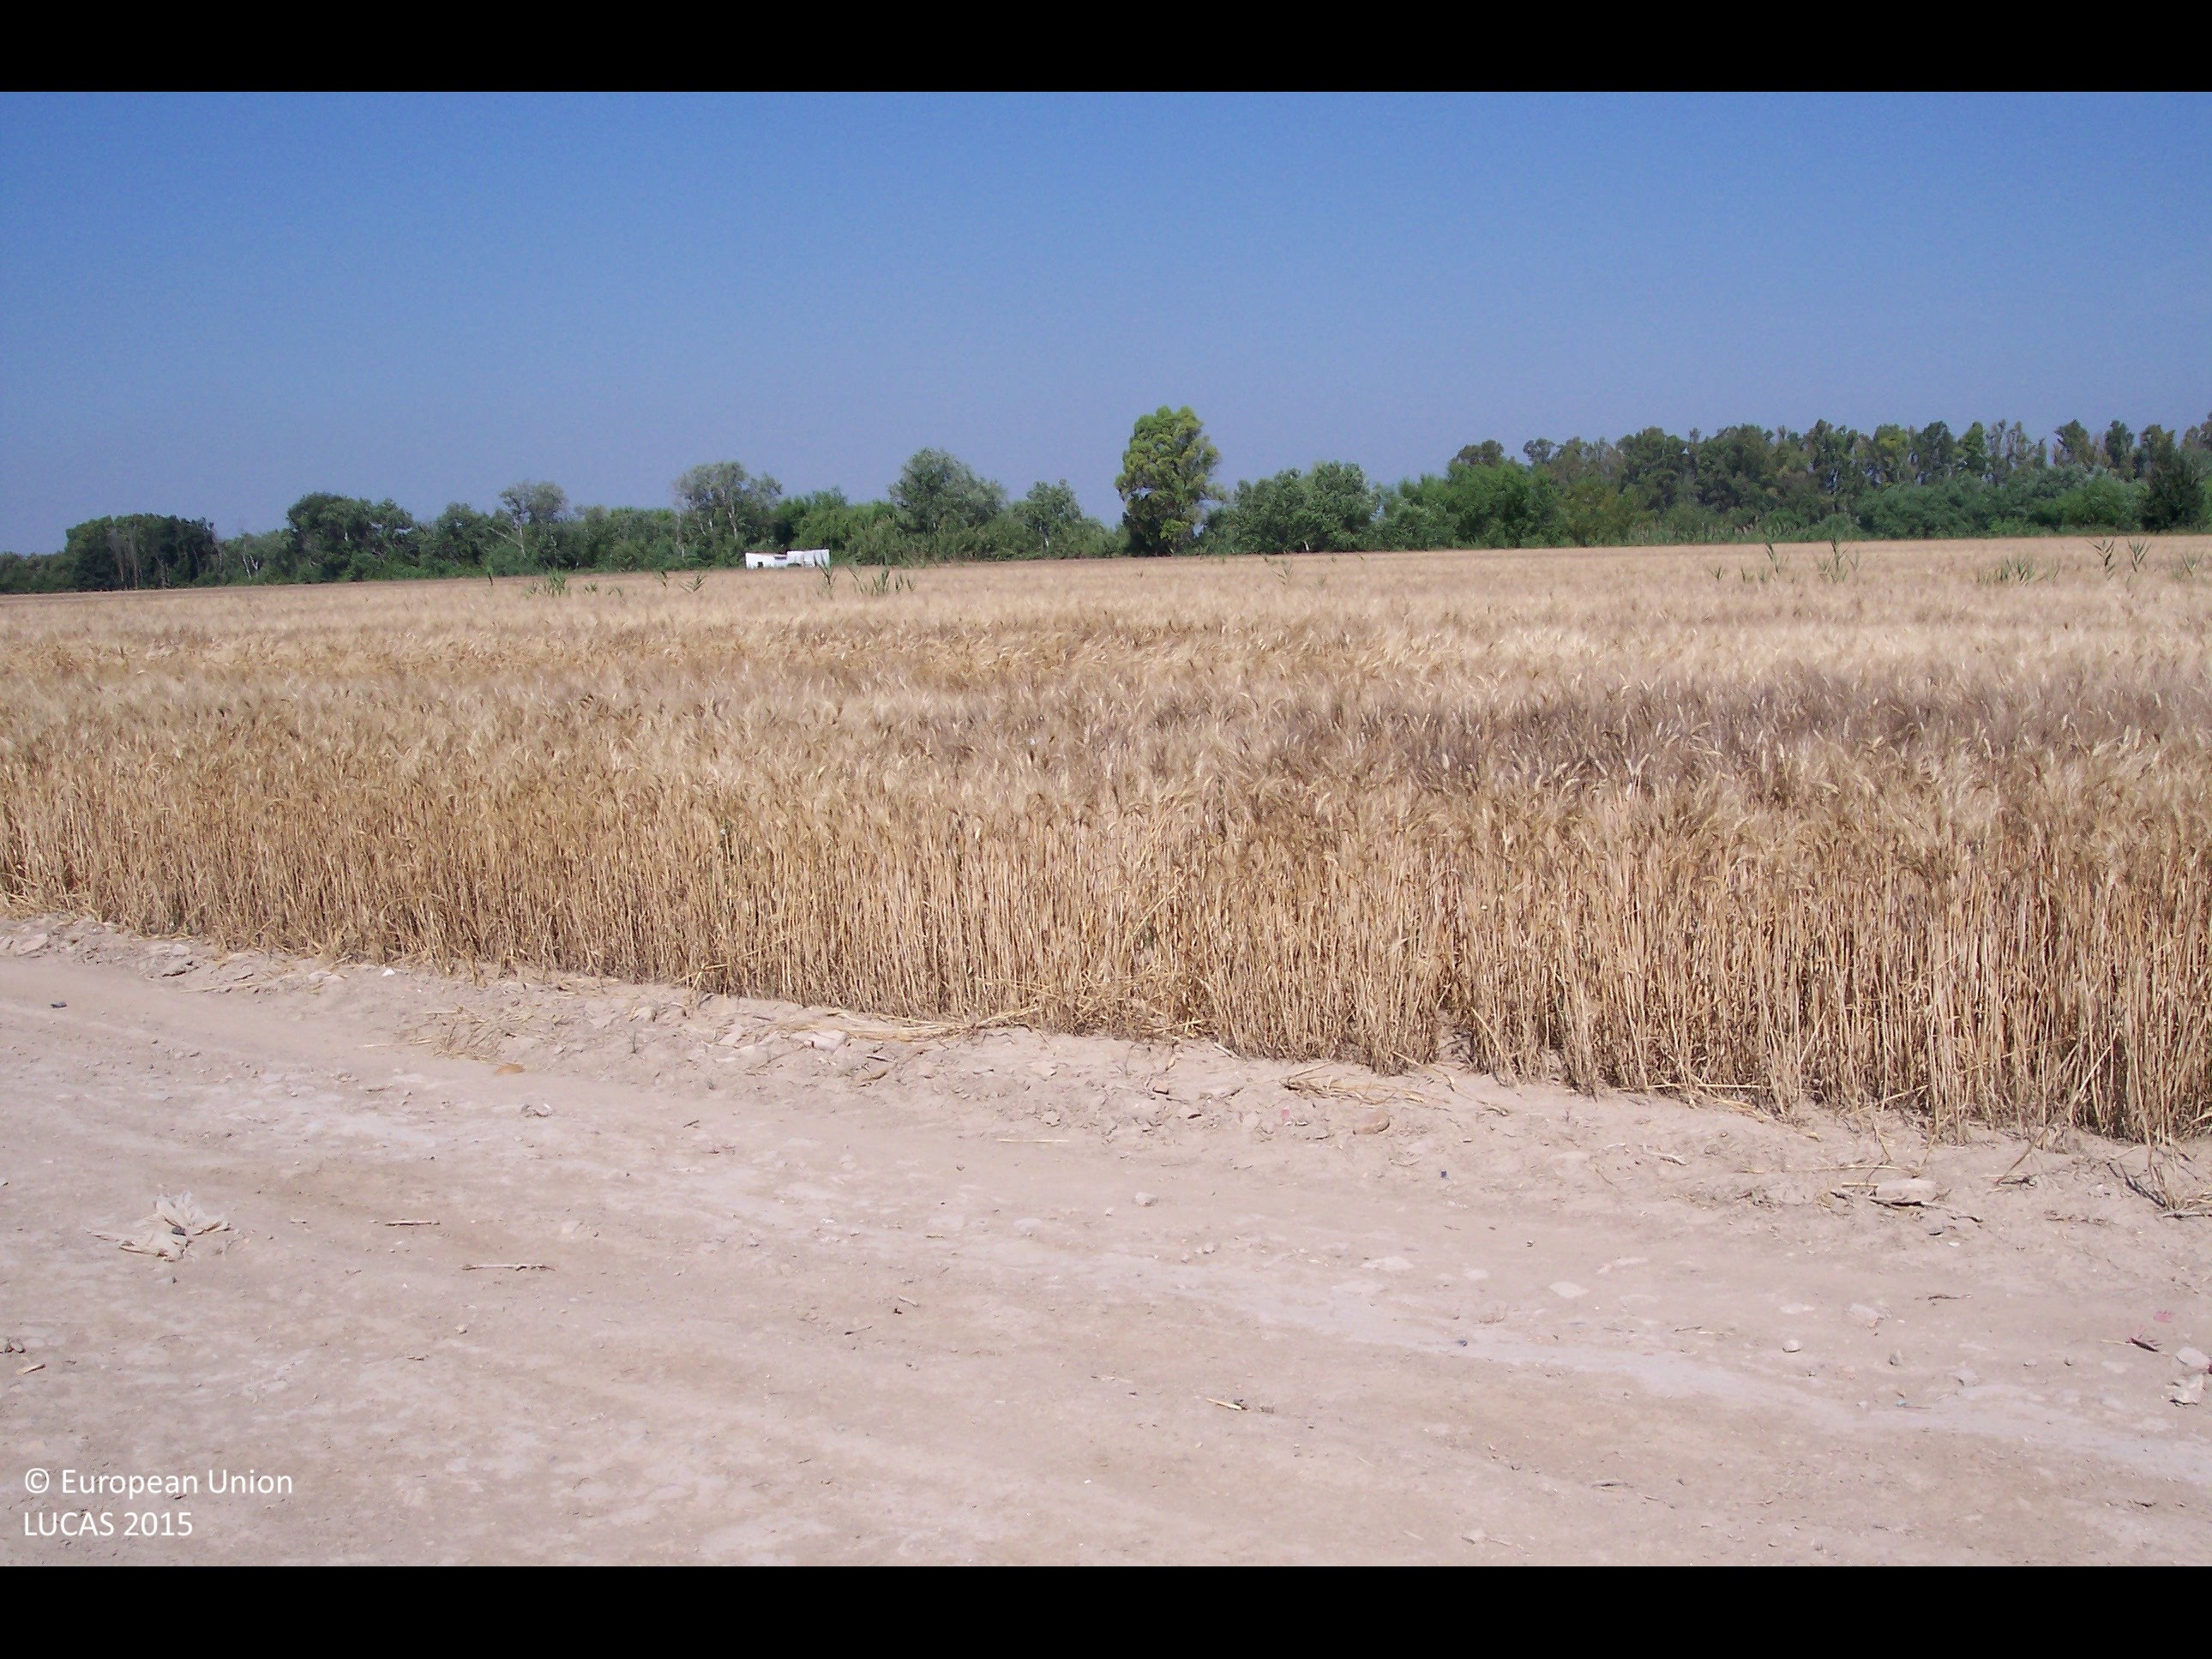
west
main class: Cropland
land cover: Durum wheat
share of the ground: > 75 %
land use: Agriculture (excluding fallow land and kitchen gardens)
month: May
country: ES
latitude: 37.2215
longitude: -6.0585
